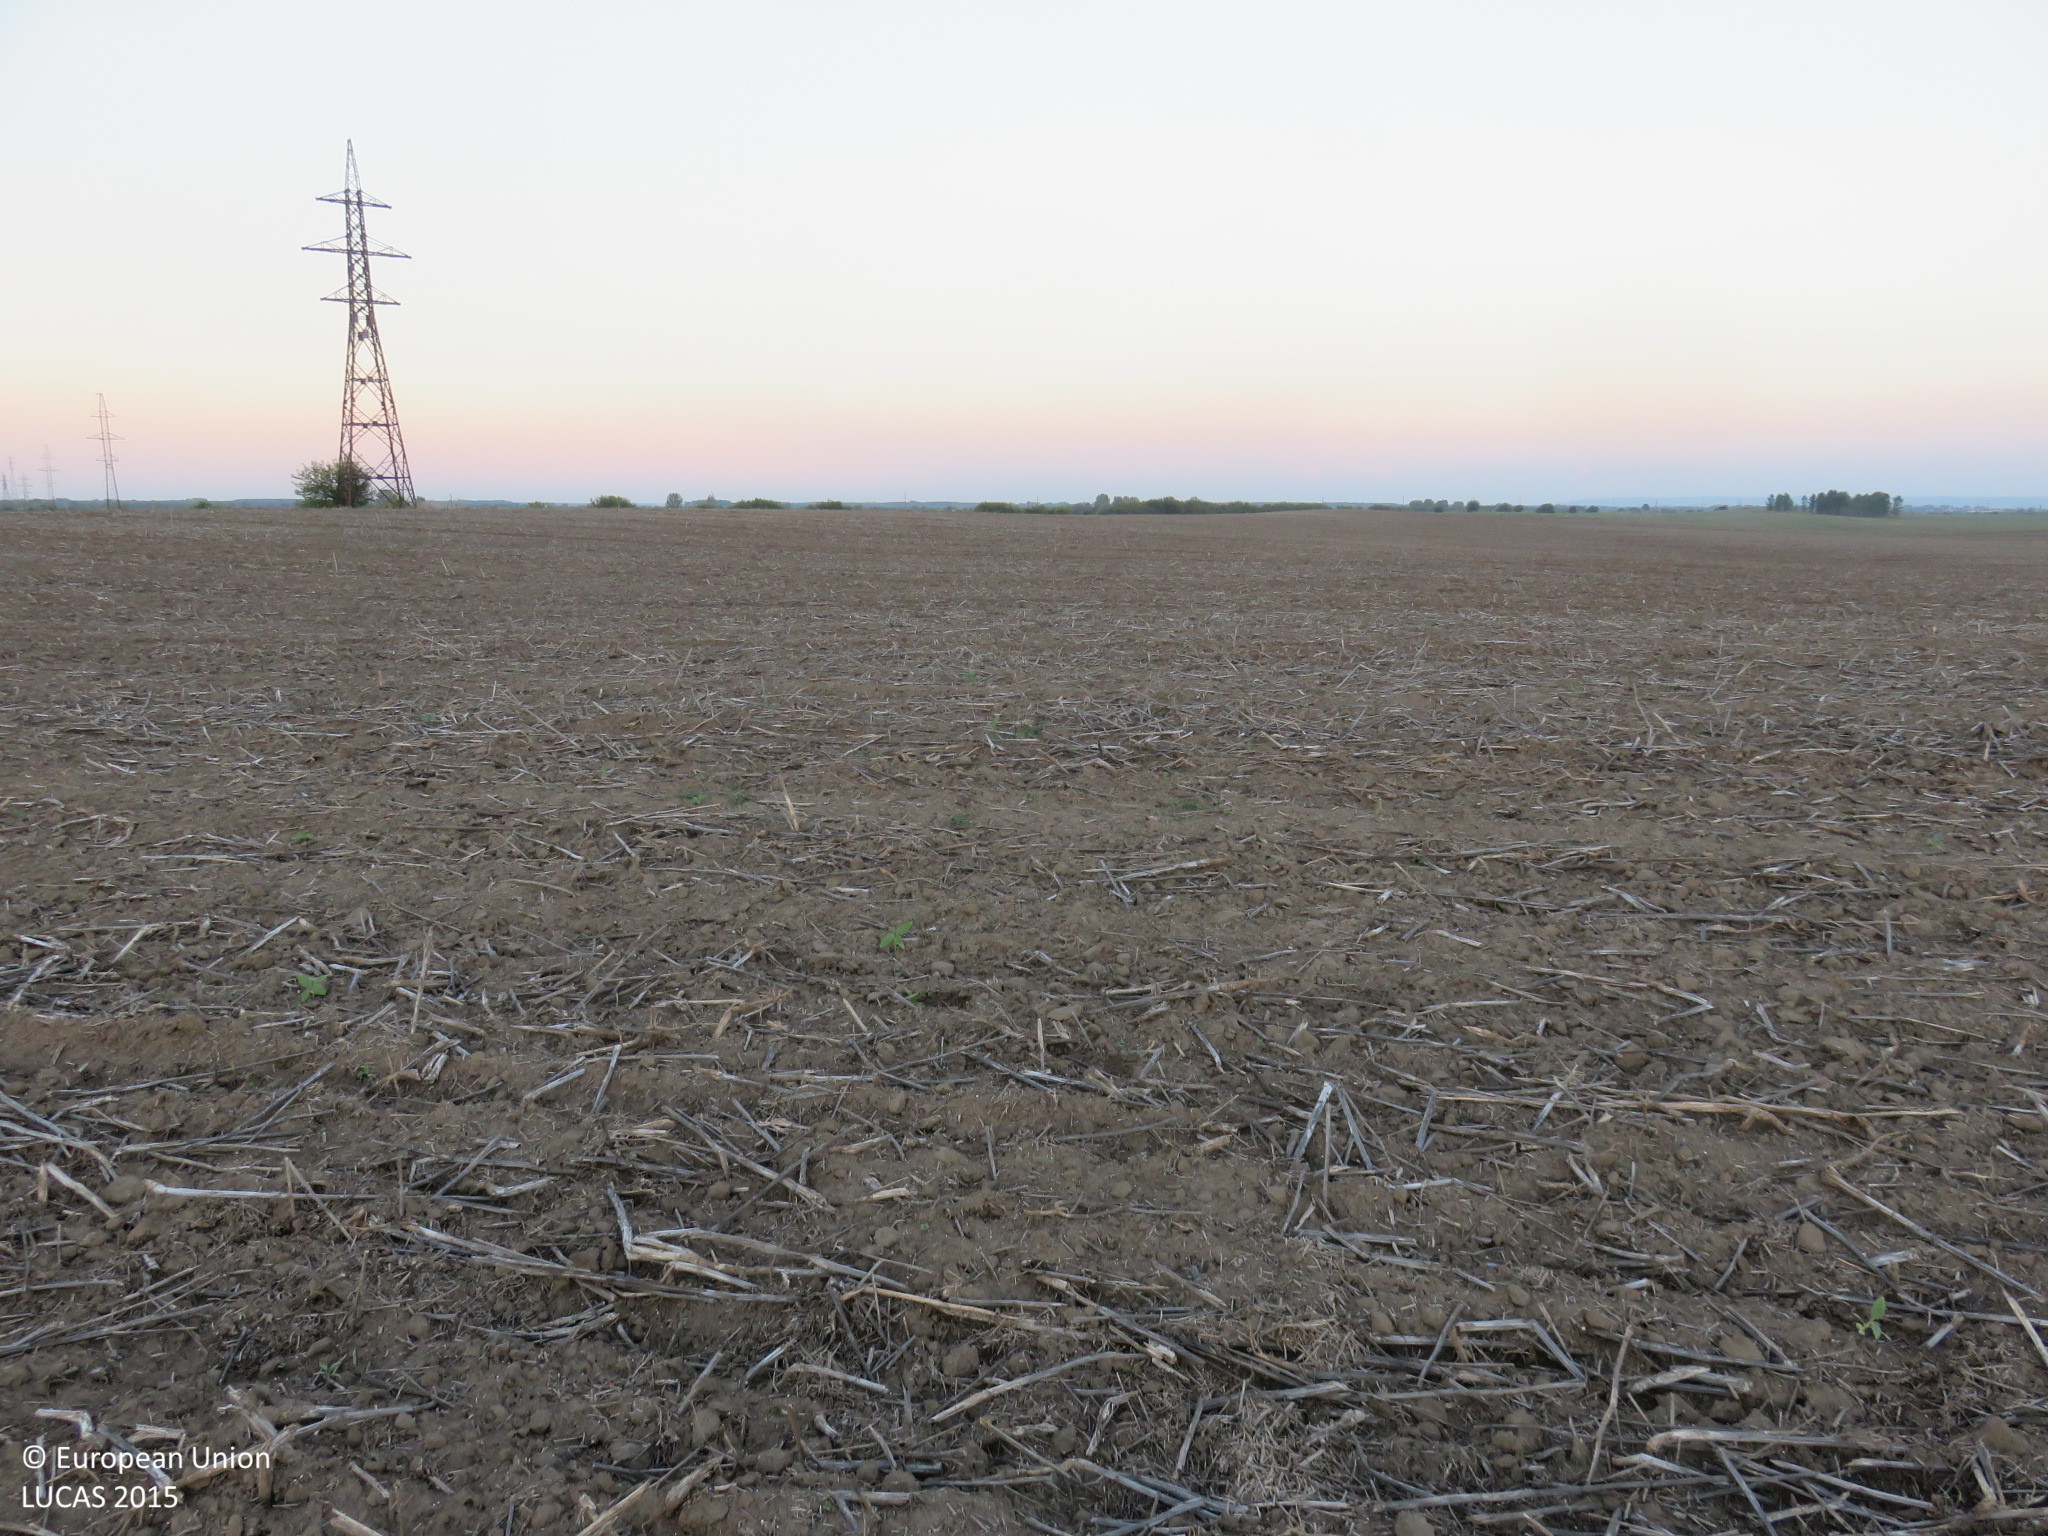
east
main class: Cropland
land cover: Rape and turnip rape
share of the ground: < 10 %
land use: Agriculture (excluding fallow land and kitchen gardens)
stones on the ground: < 10 %
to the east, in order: Rape and turnip rape; Electric lines; Rape and turnip rape
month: September
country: BG
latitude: 43.6679
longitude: 25.0429
